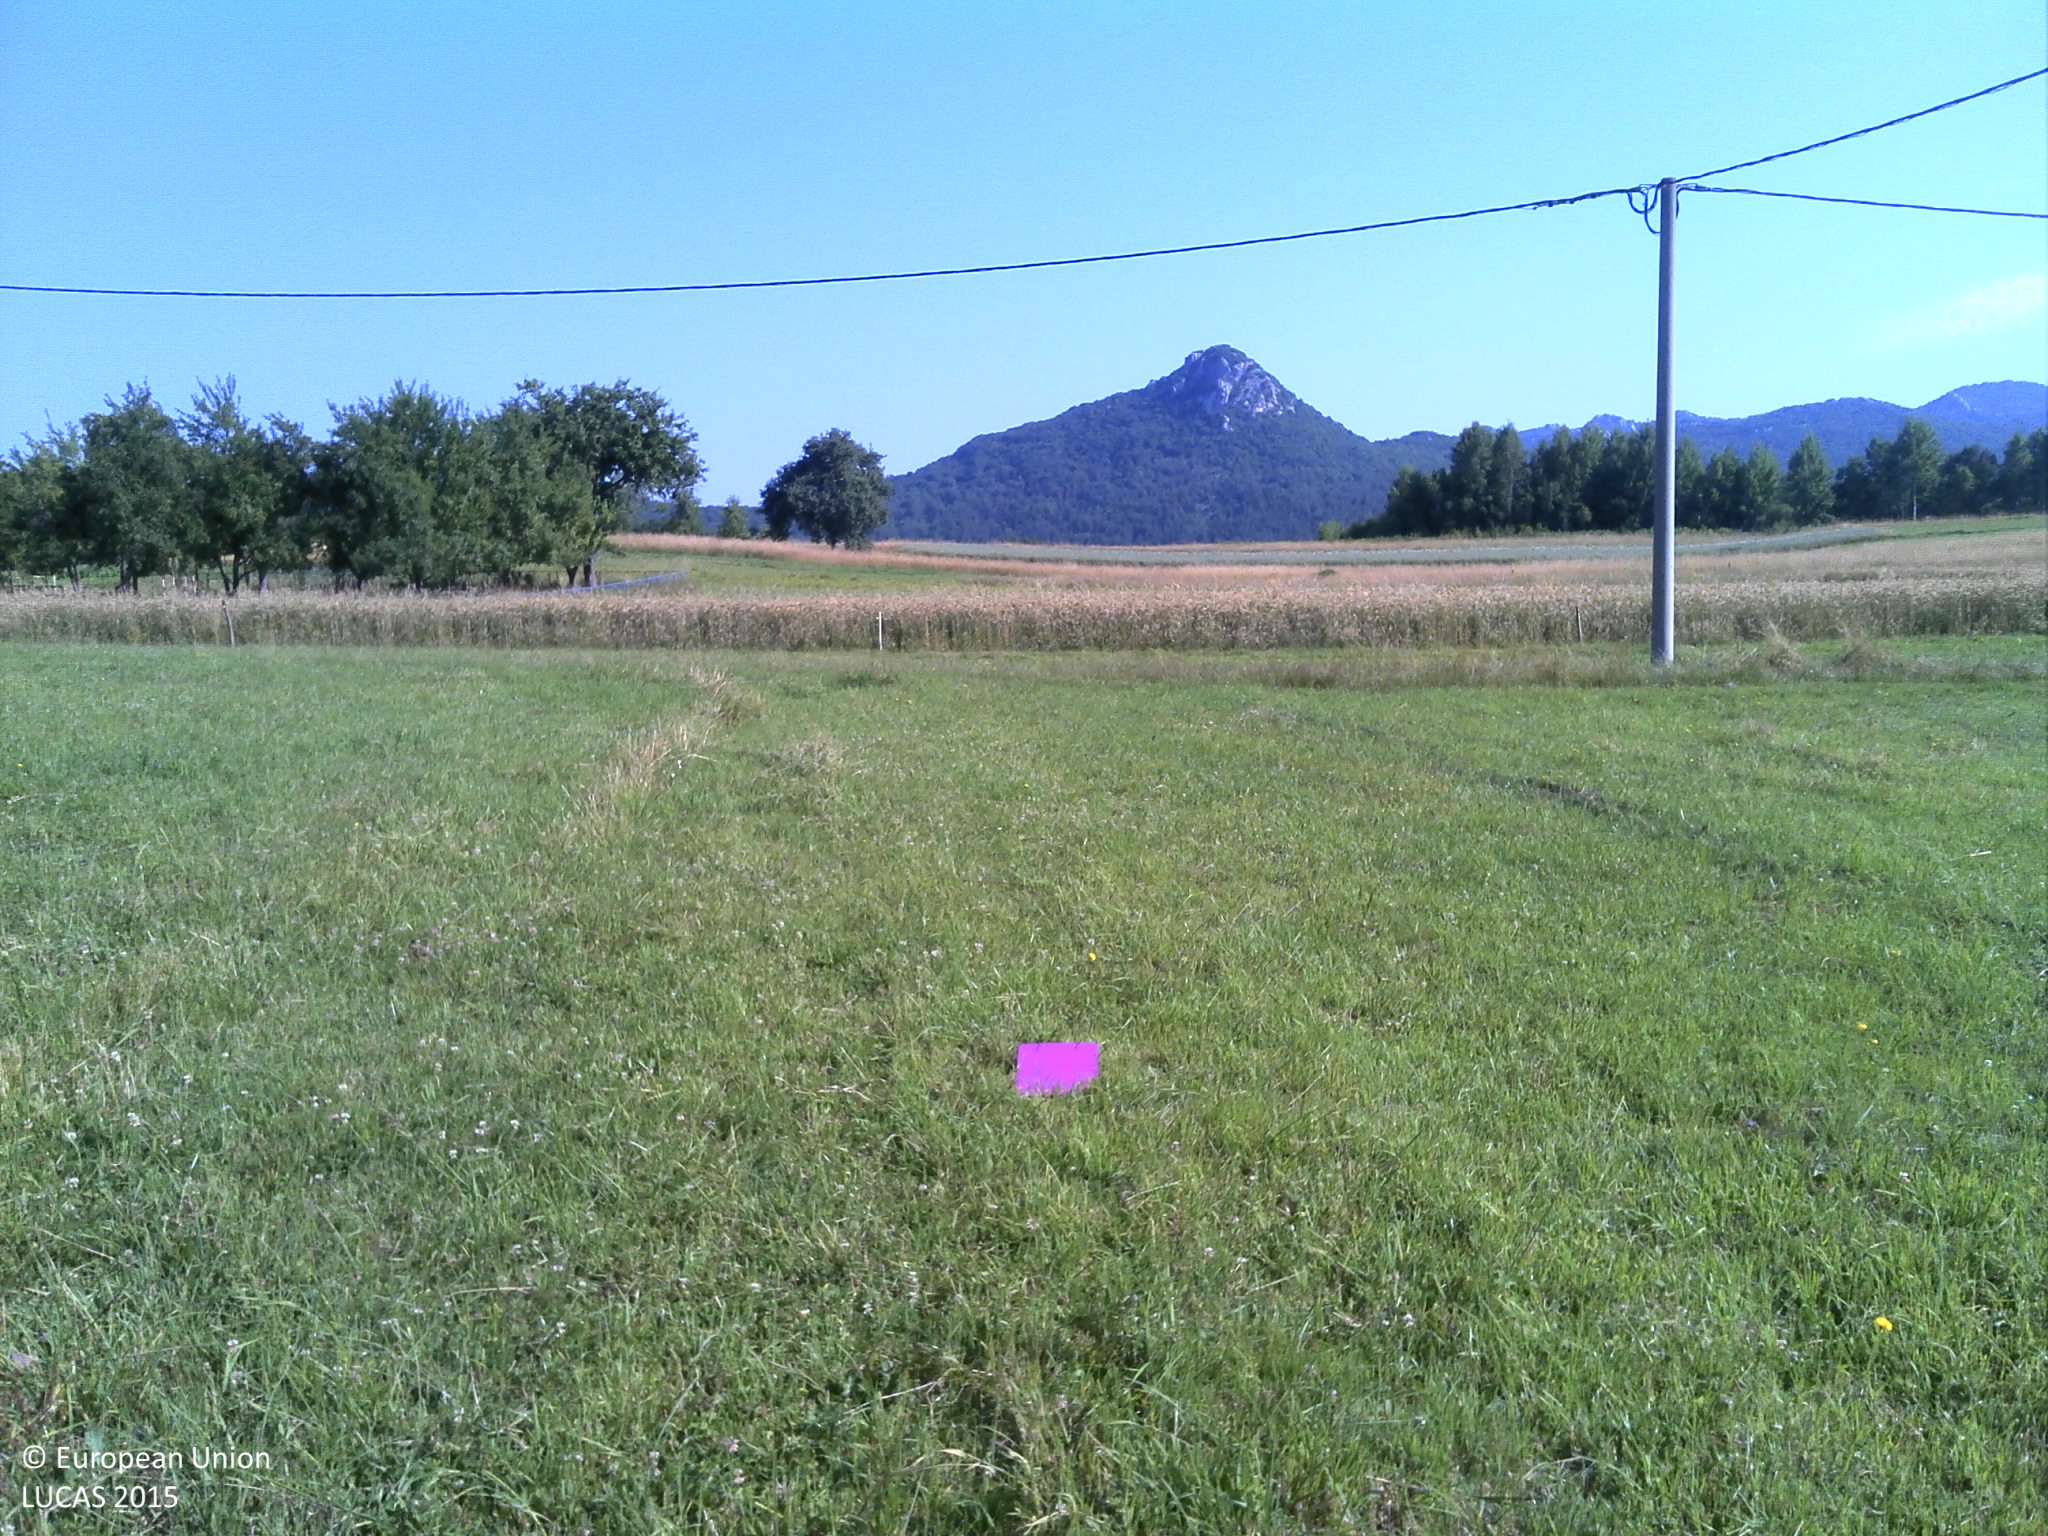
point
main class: Grassland
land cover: Grassland without tree/shrub cover
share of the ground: > 75 %
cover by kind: herbaceous plants 100 %
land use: Agriculture (excluding fallow land and kitchen gardens)
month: July
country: HR
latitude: 44.6345
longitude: 15.2250
